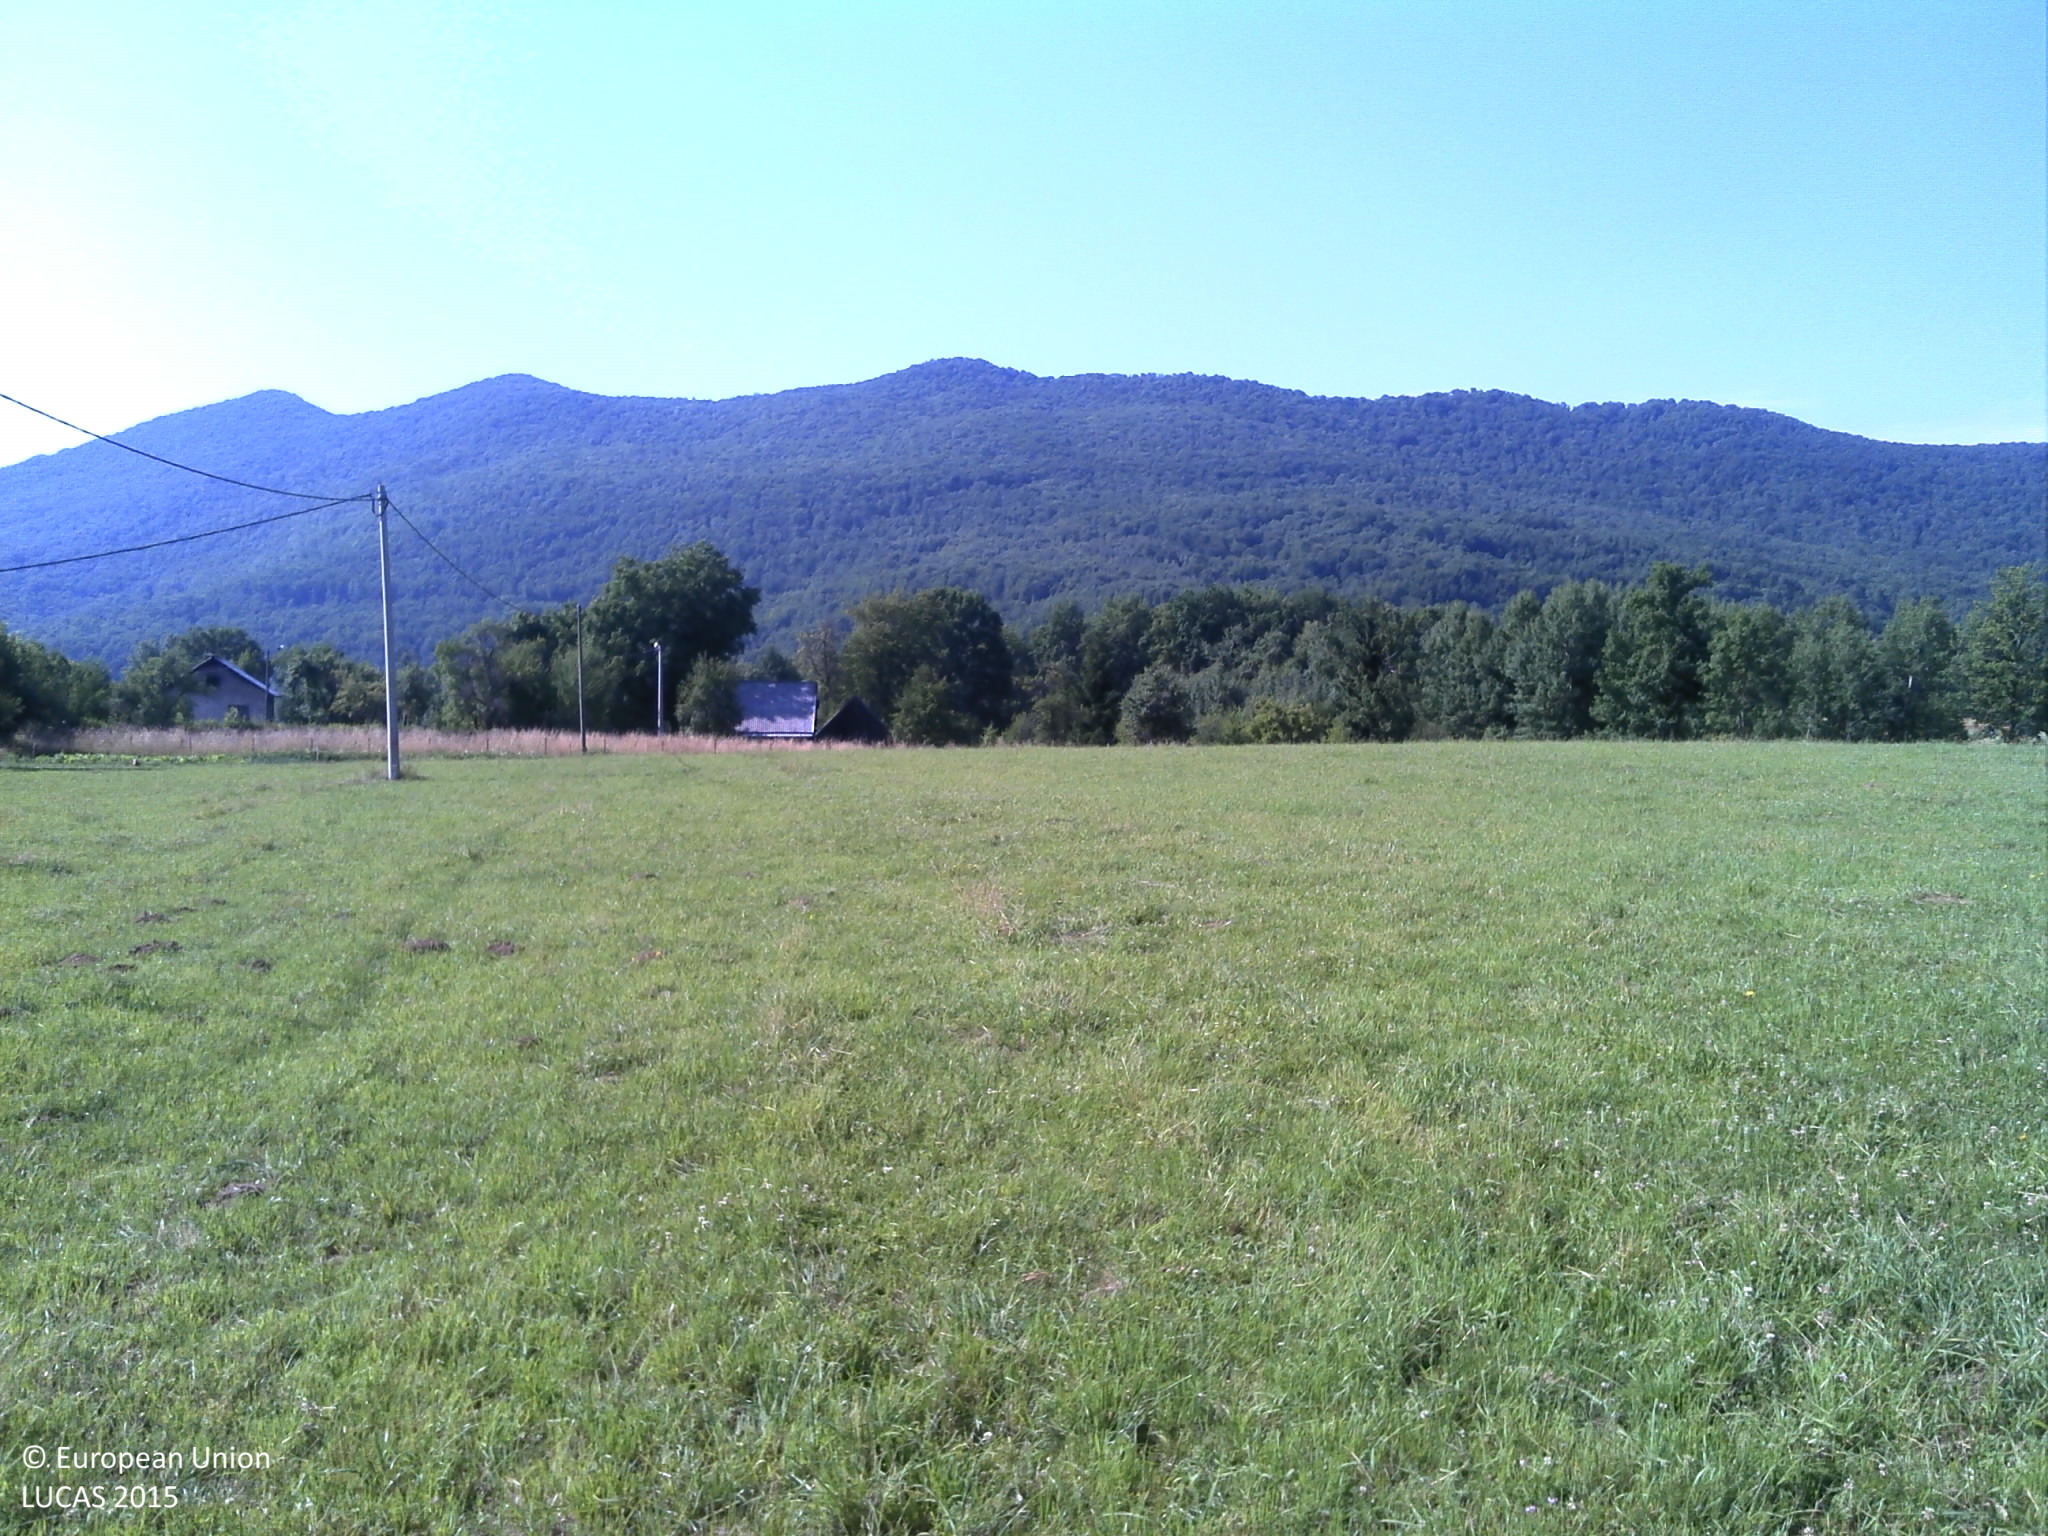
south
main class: Grassland
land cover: Grassland without tree/shrub cover
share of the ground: > 75 %
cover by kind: herbaceous plants 100 %
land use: Agriculture (excluding fallow land and kitchen gardens)
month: July
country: HR
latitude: 44.6345
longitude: 15.2250
